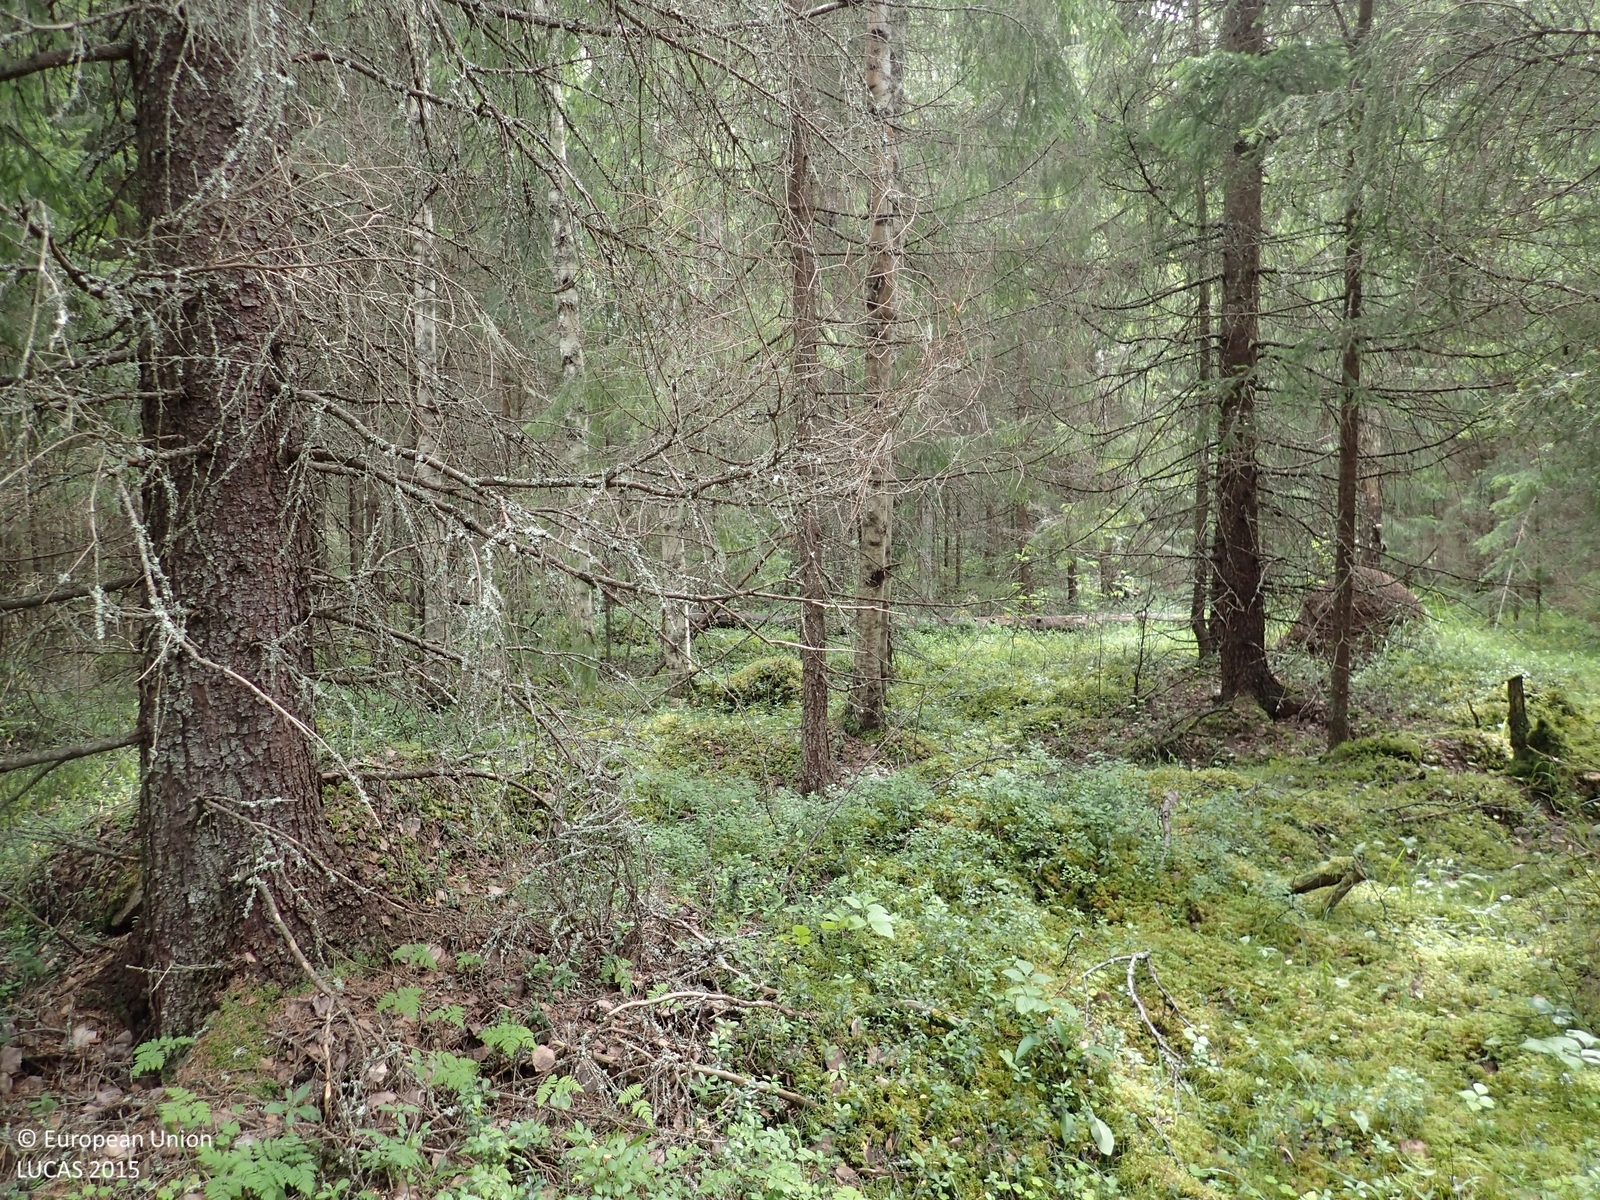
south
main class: Woodland
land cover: Spruce dominated mixed woodland
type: boreal forest
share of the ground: > 75 %
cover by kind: coniferous forest trees 60 %, broadleaved forest trees 20 %, herbaceous plants 10 %, shrubs 5 %, lichens and mosses 5 %
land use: Forestry
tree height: > 5 m
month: August
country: FI
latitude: 62.8314
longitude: 21.9221
